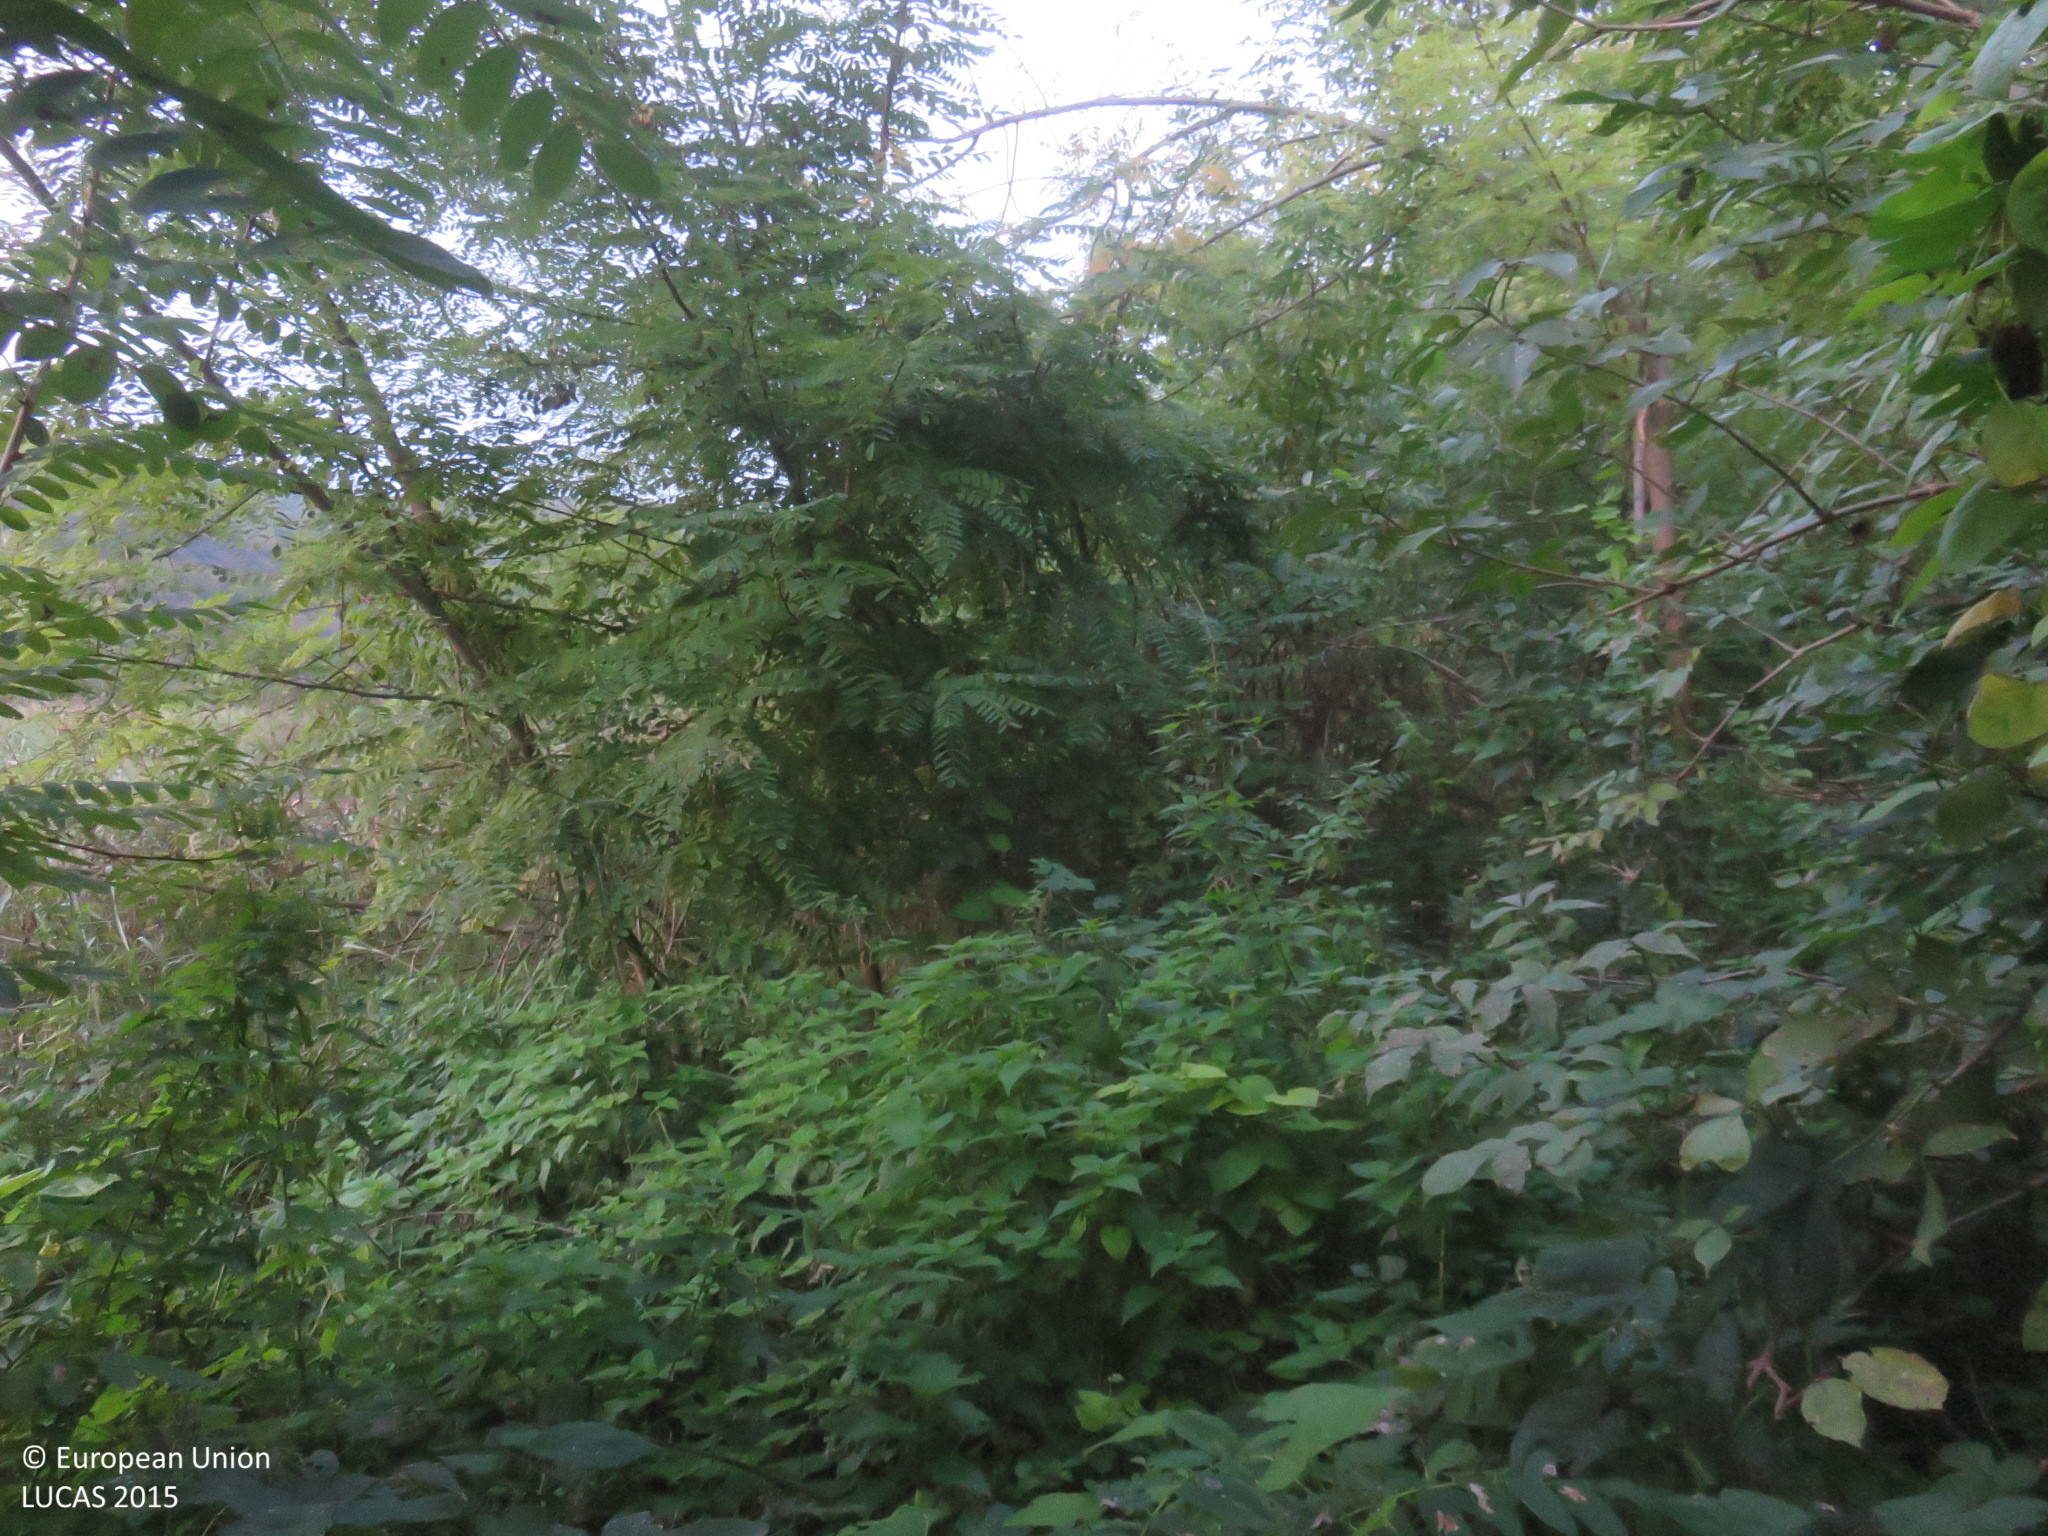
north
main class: Woodland
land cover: Broadleaved woodland
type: mesophytic deciduous forest
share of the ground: > 75 %
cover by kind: broadleaved forest trees 70 %, shrubs 30 %
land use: Semi-natural and natural areas not in use
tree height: < 5 m
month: October
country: BG
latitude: 43.1520
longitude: 25.1843
